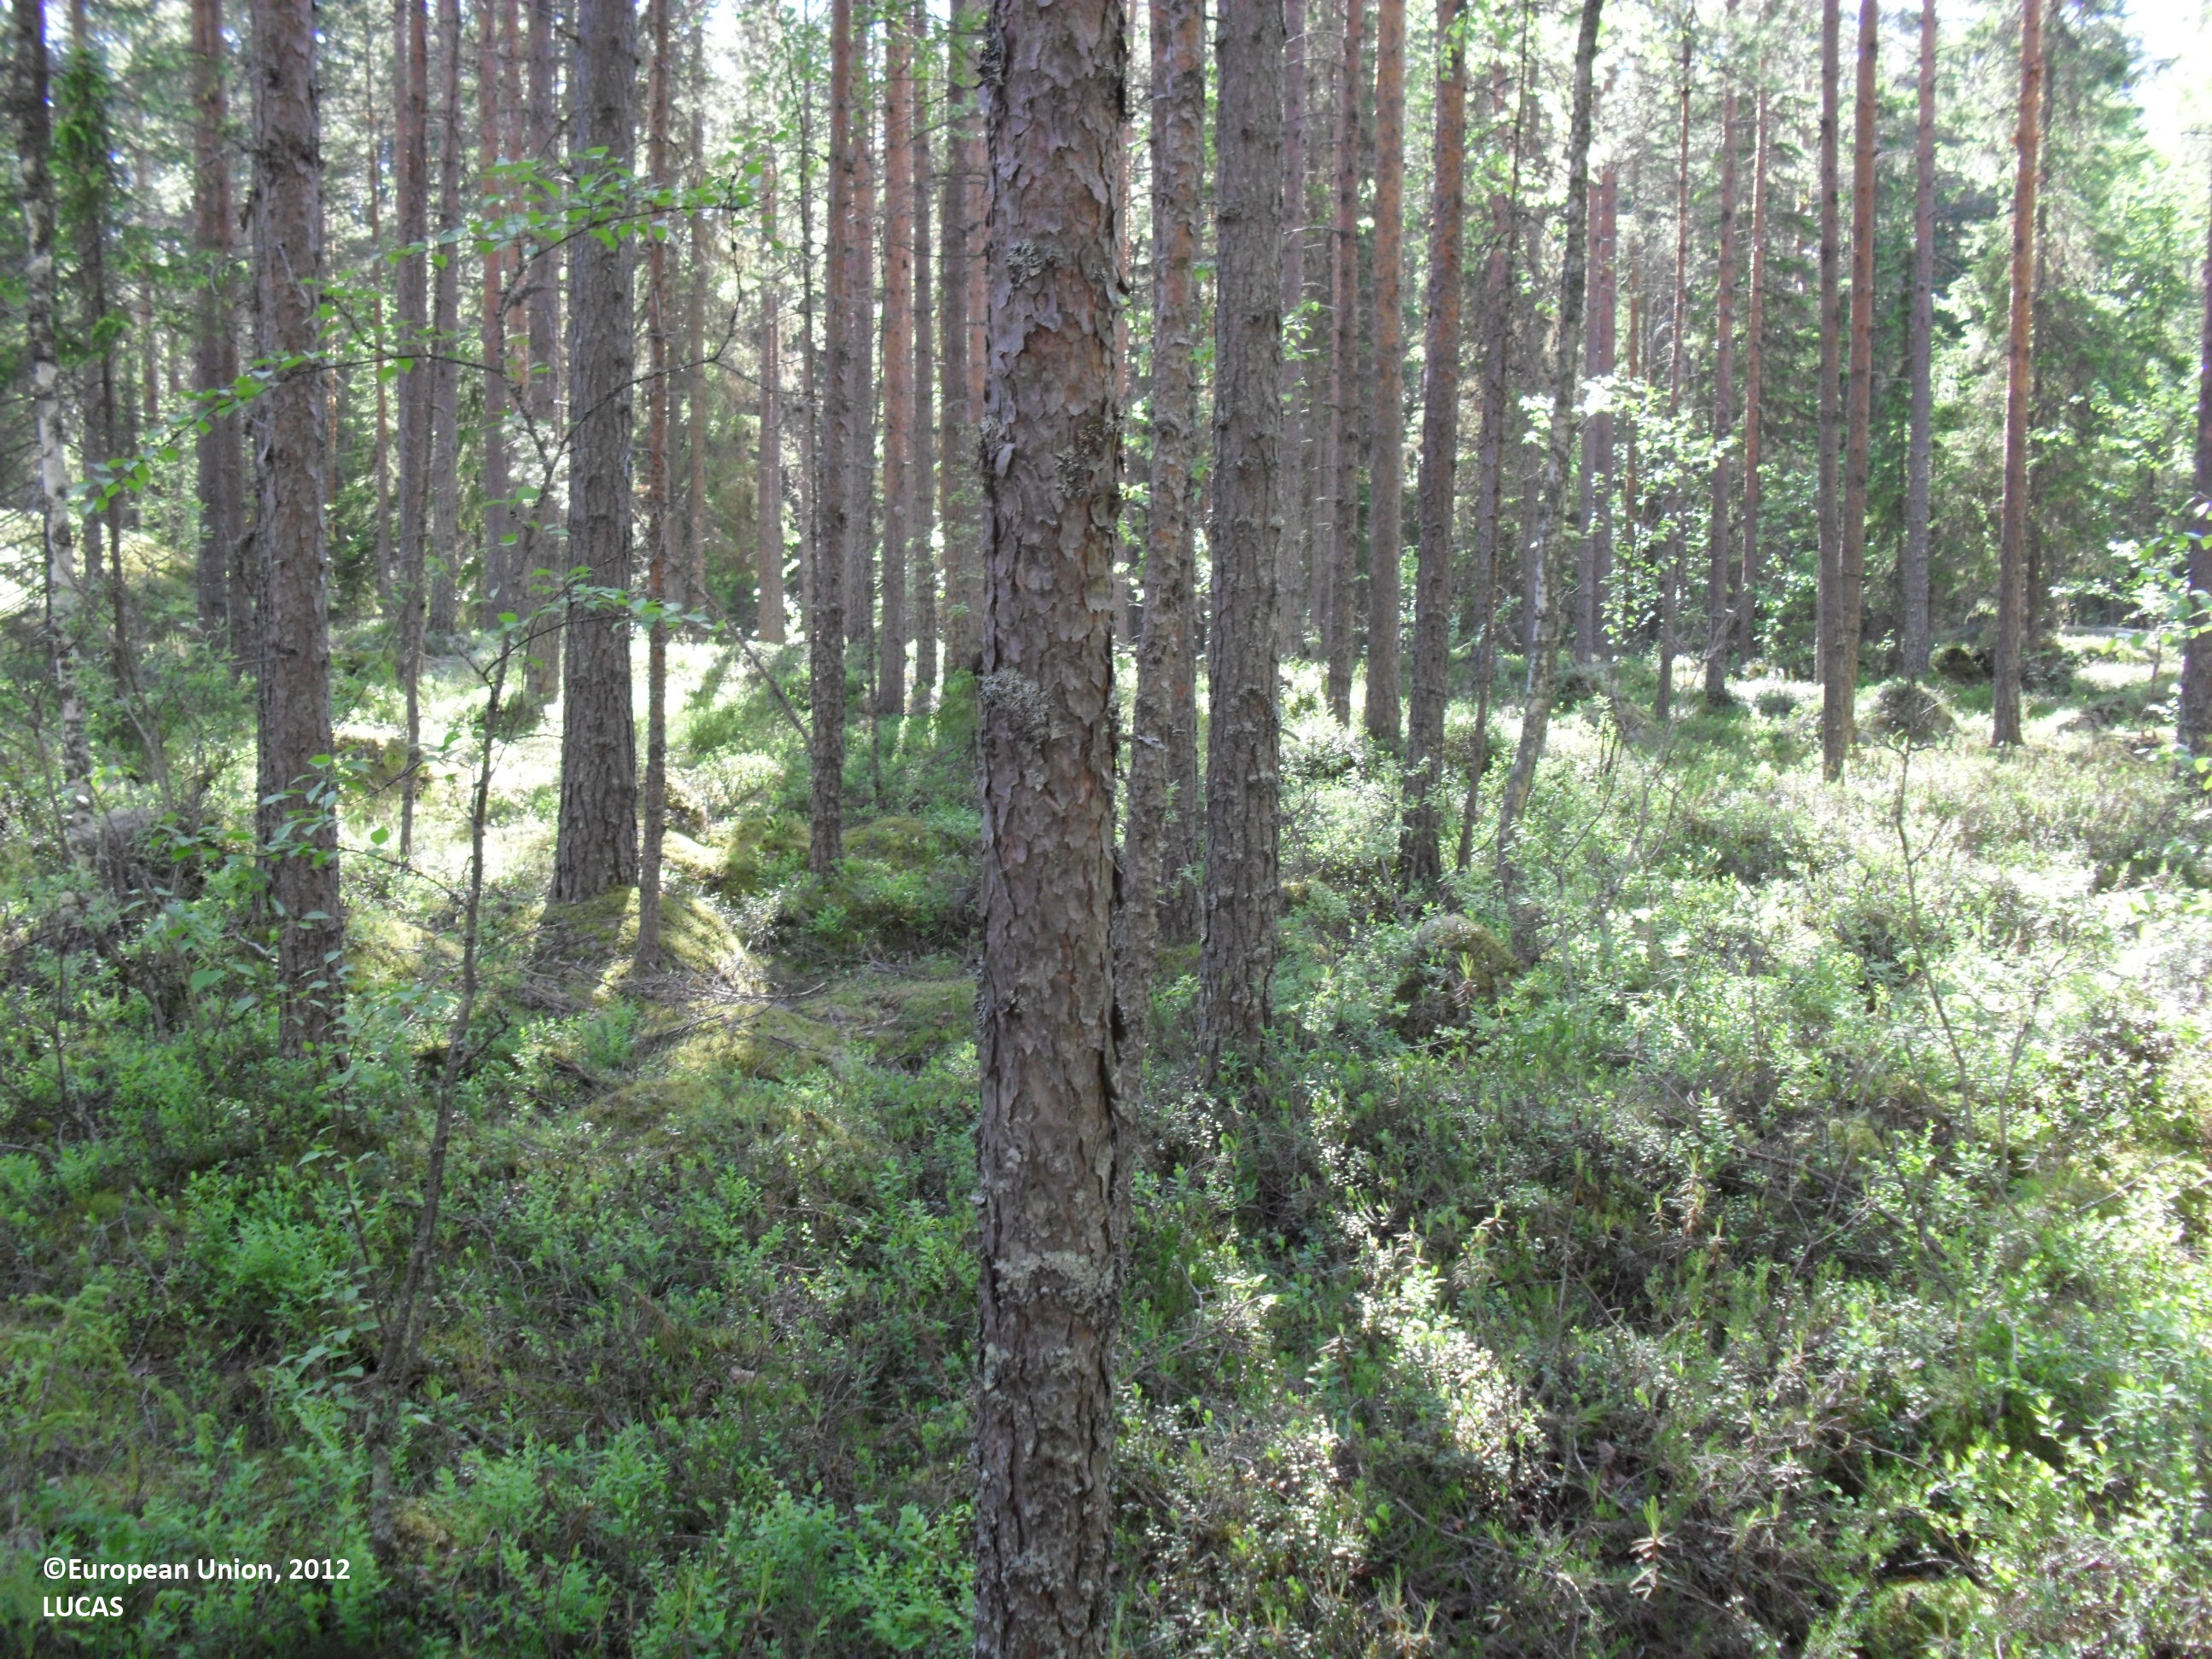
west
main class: Woodland
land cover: Pine dominated mixed woodland
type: boreal forest
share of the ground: 50 - 75 %
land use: Forestry
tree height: > 5 m
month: June
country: FI
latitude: 62.9482
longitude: 23.3684
